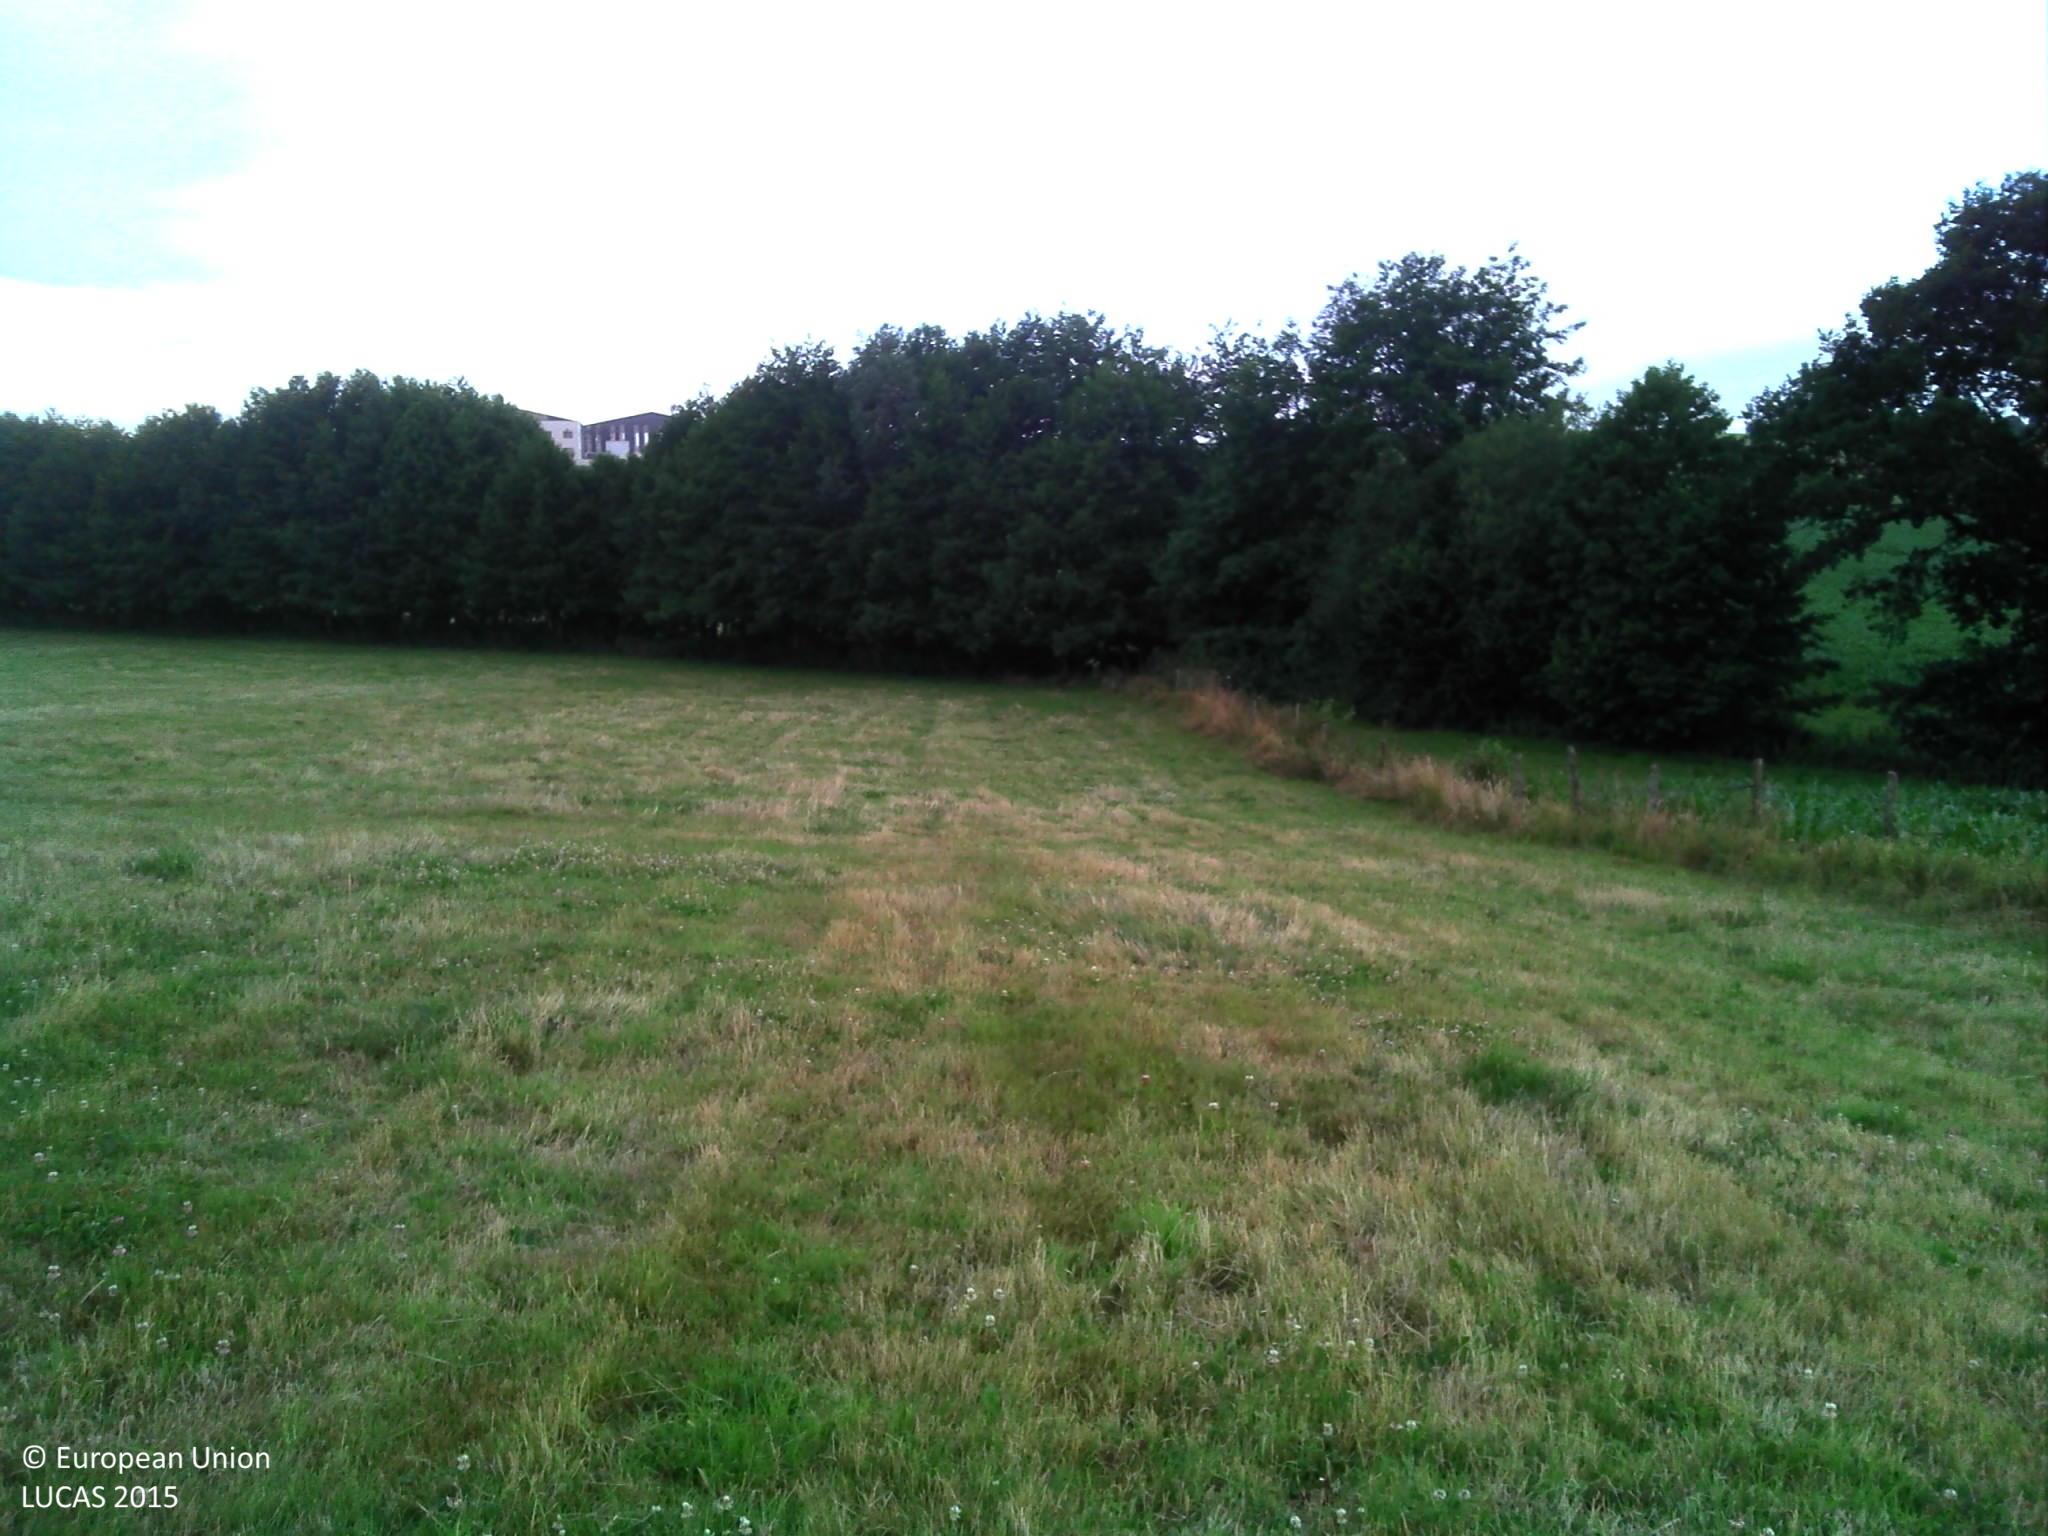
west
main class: Grassland
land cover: Grassland without tree/shrub cover
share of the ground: > 75 %
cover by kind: herbaceous plants 100 %
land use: Agriculture (excluding fallow land and kitchen gardens)
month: June
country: FR
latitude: 47.9708
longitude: -1.4434
